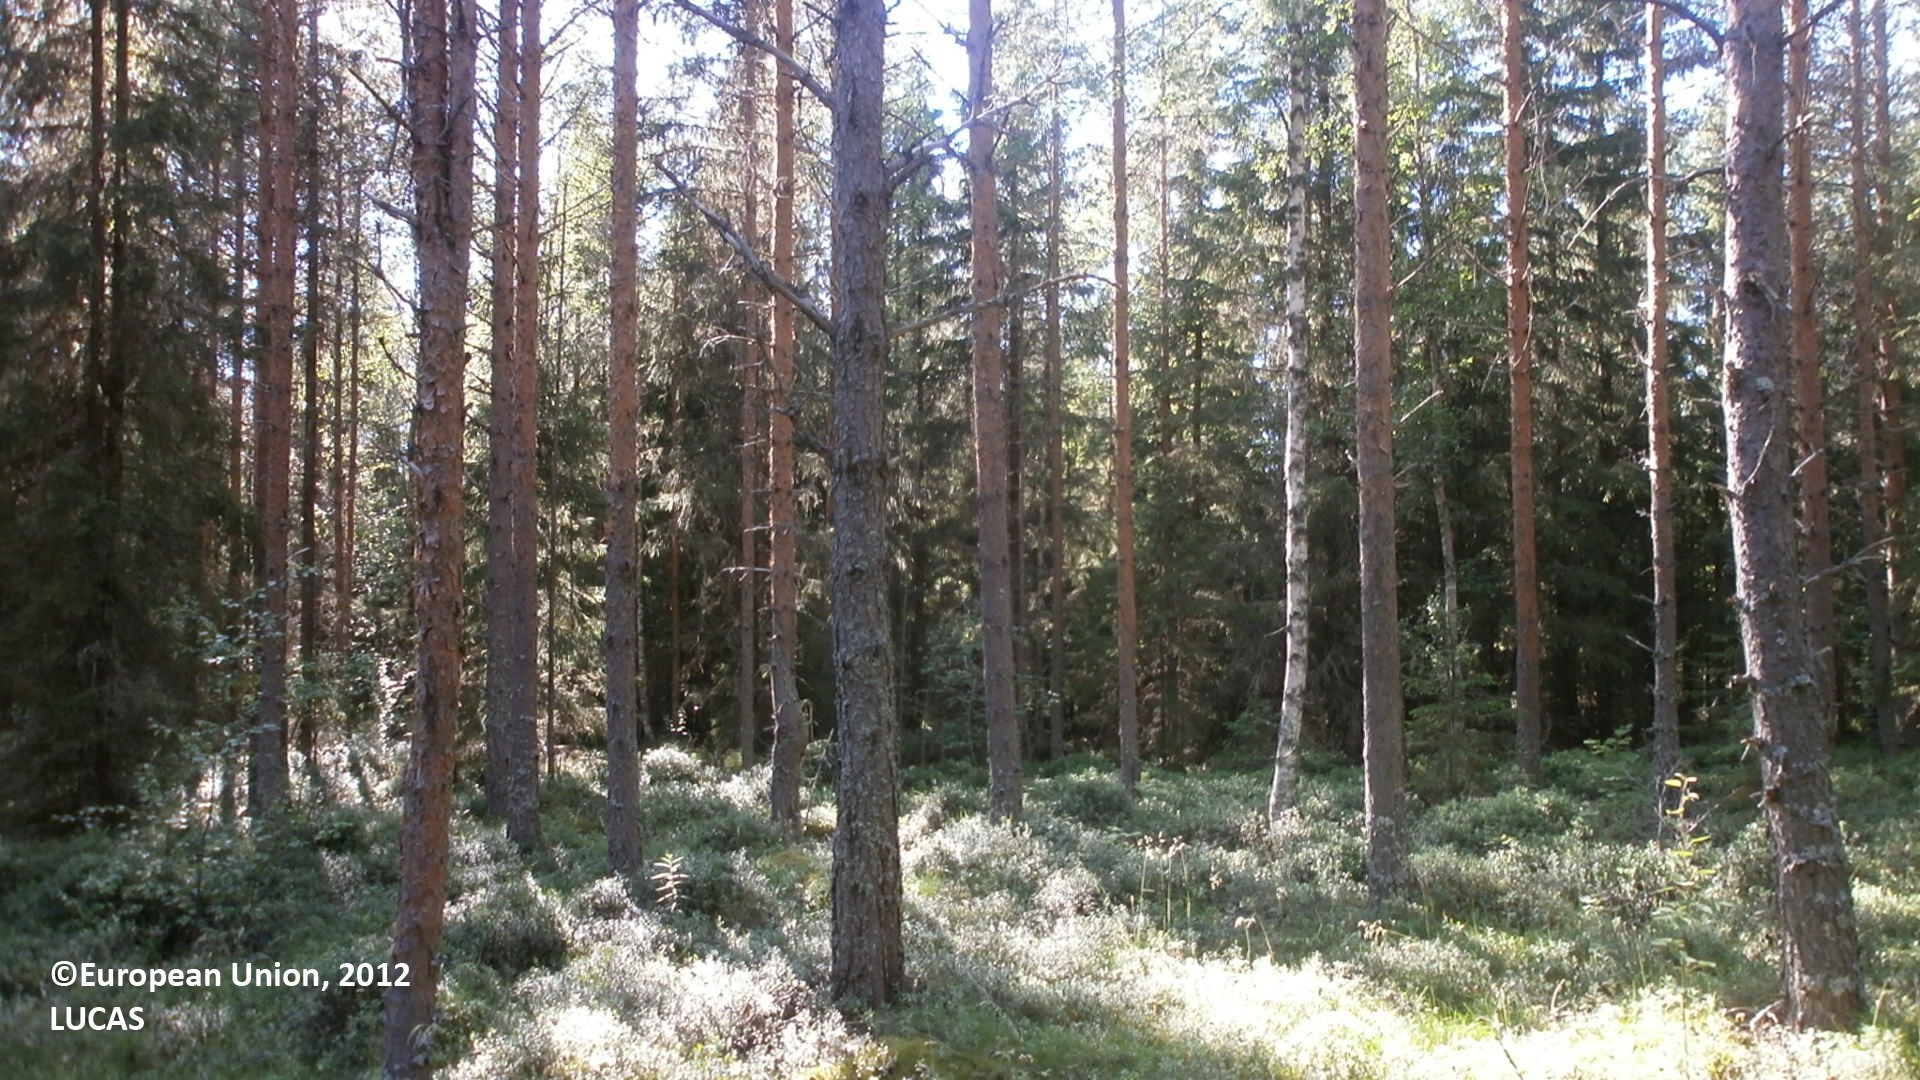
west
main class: Woodland
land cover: Pine dominated coniferous woodland
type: boreal forest
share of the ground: 50 - 75 %
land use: Forestry
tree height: > 5 m
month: July
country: FI
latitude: 64.3023
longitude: 24.0563
